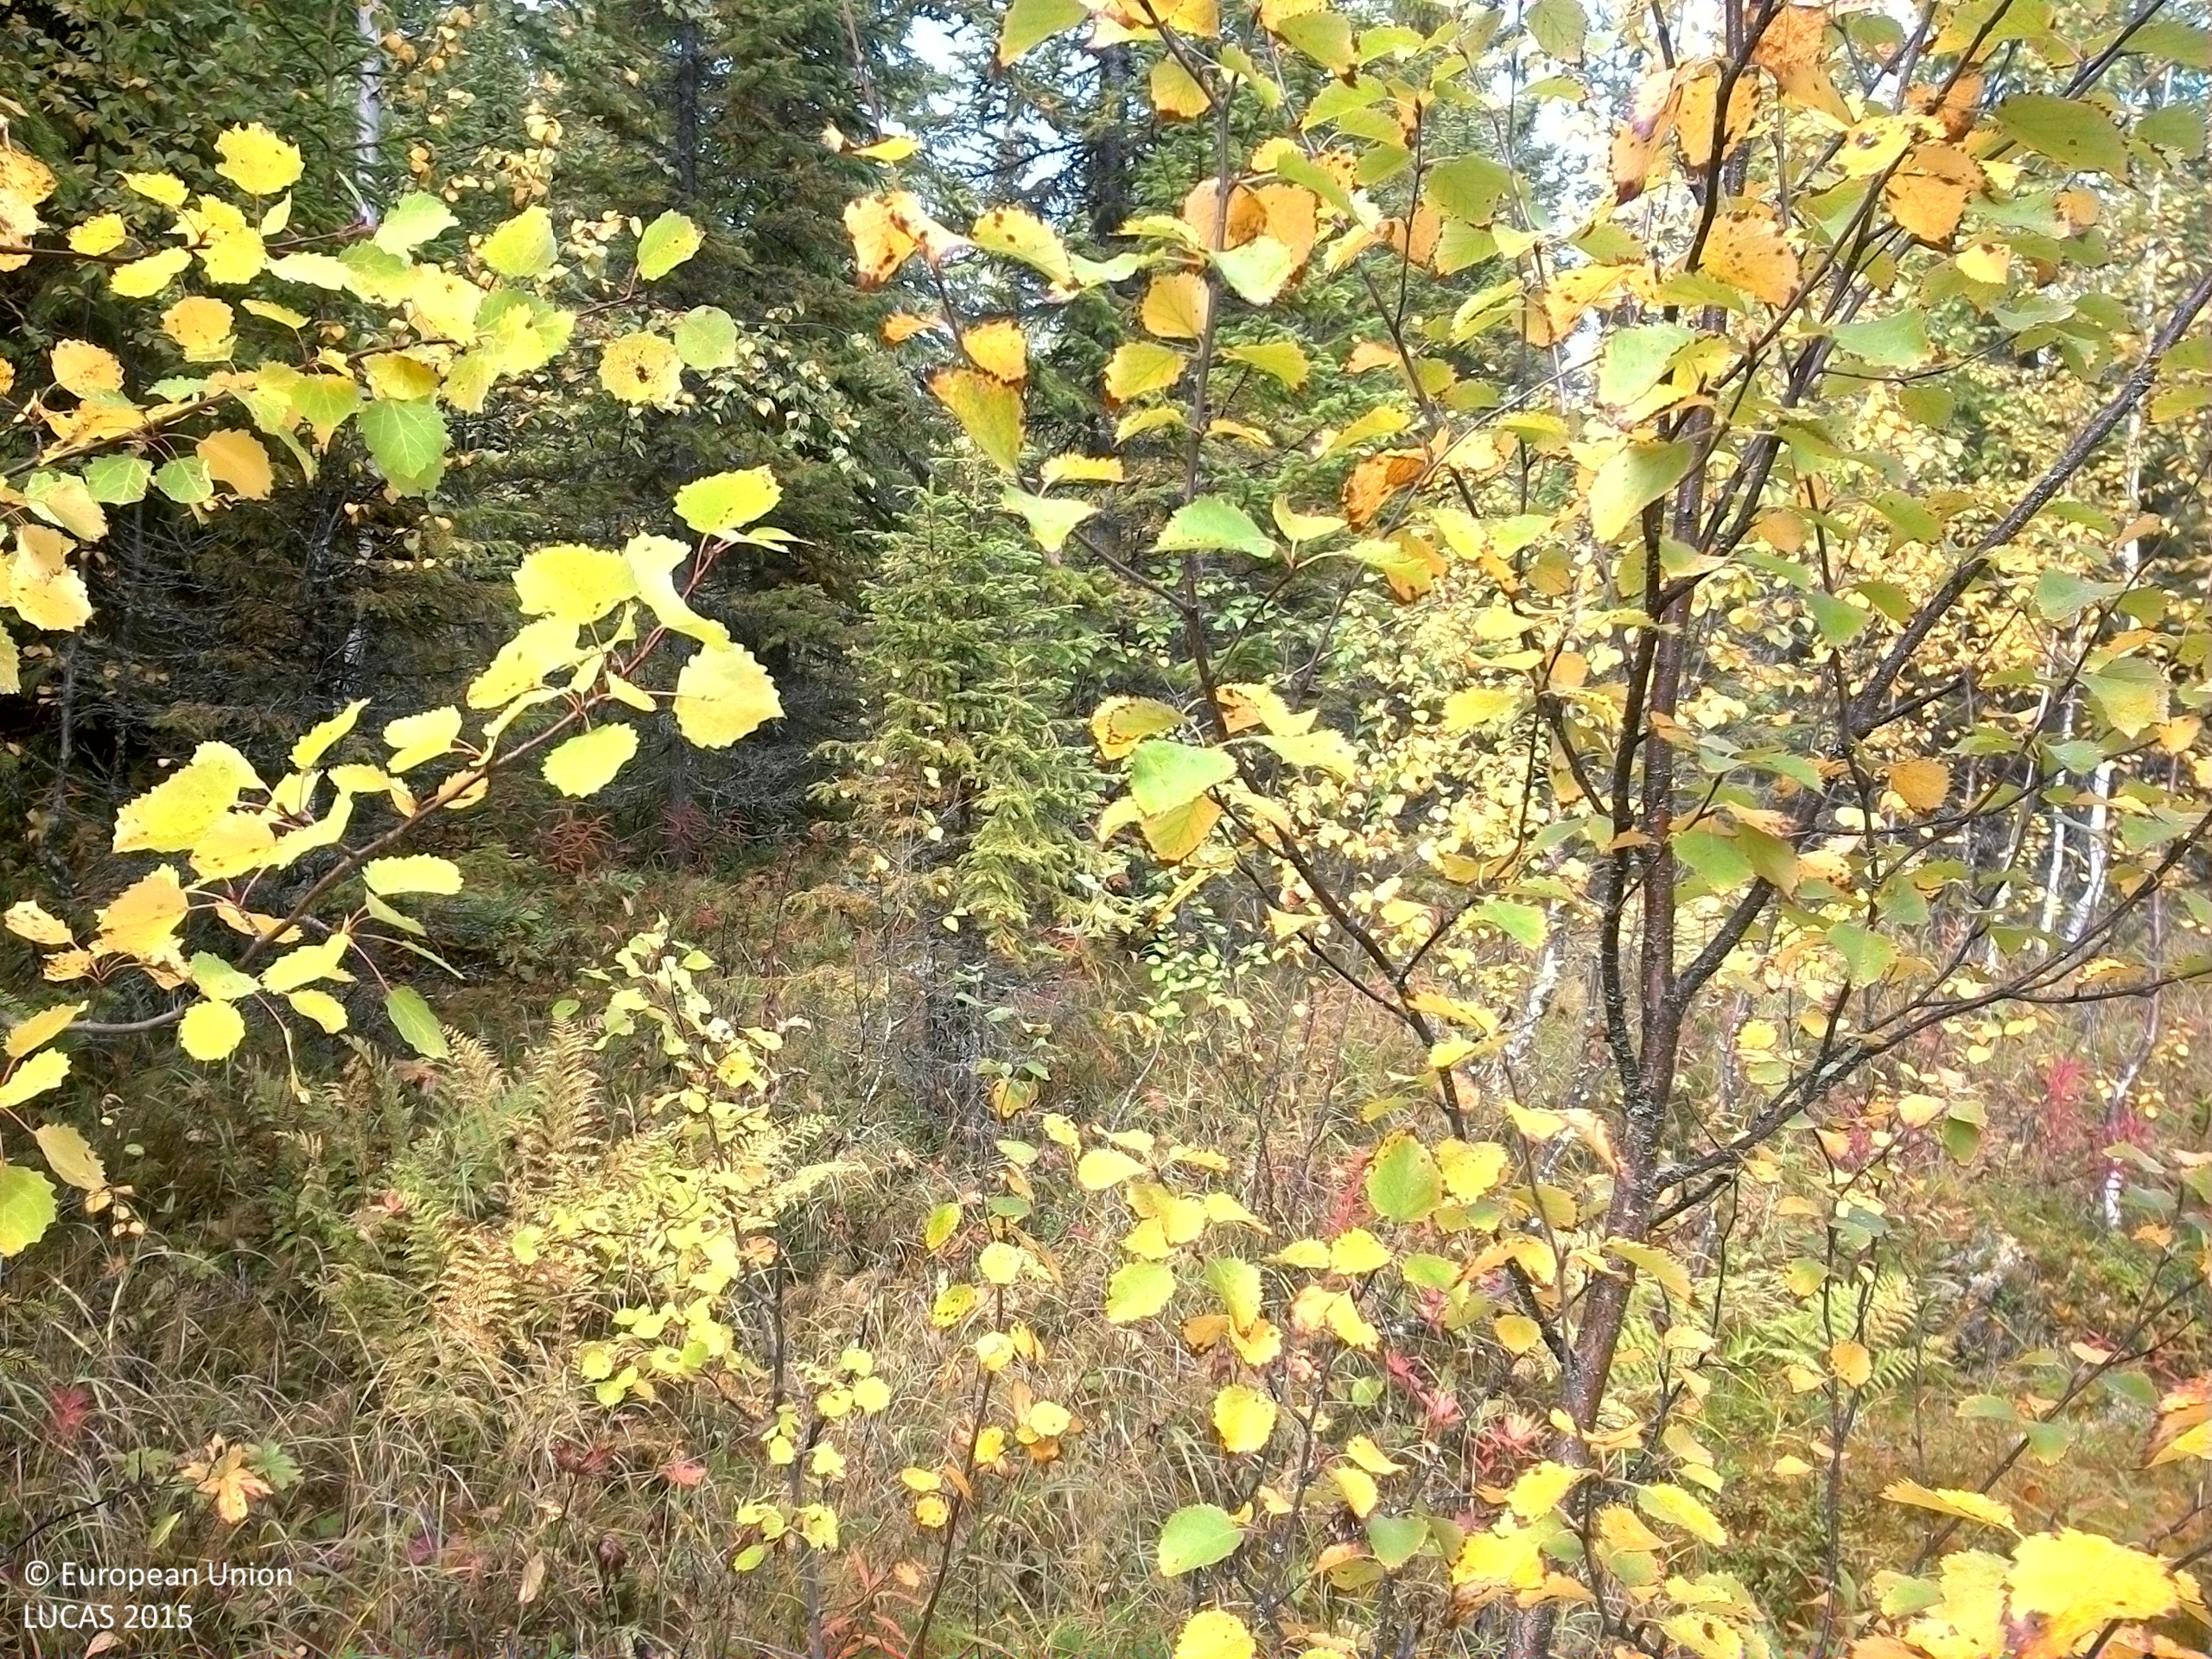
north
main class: Woodland
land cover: Spruce dominated mixed woodland
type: boreal forest
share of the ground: > 75 %
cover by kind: coniferous forest trees 55 %, broadleaved forest trees 20 %, herbaceous plants 15 %, shrubs 5 %, lichens and mosses 5 %
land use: Forestry
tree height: > 5 m
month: September
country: SE
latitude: 63.5817
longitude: 15.9169
